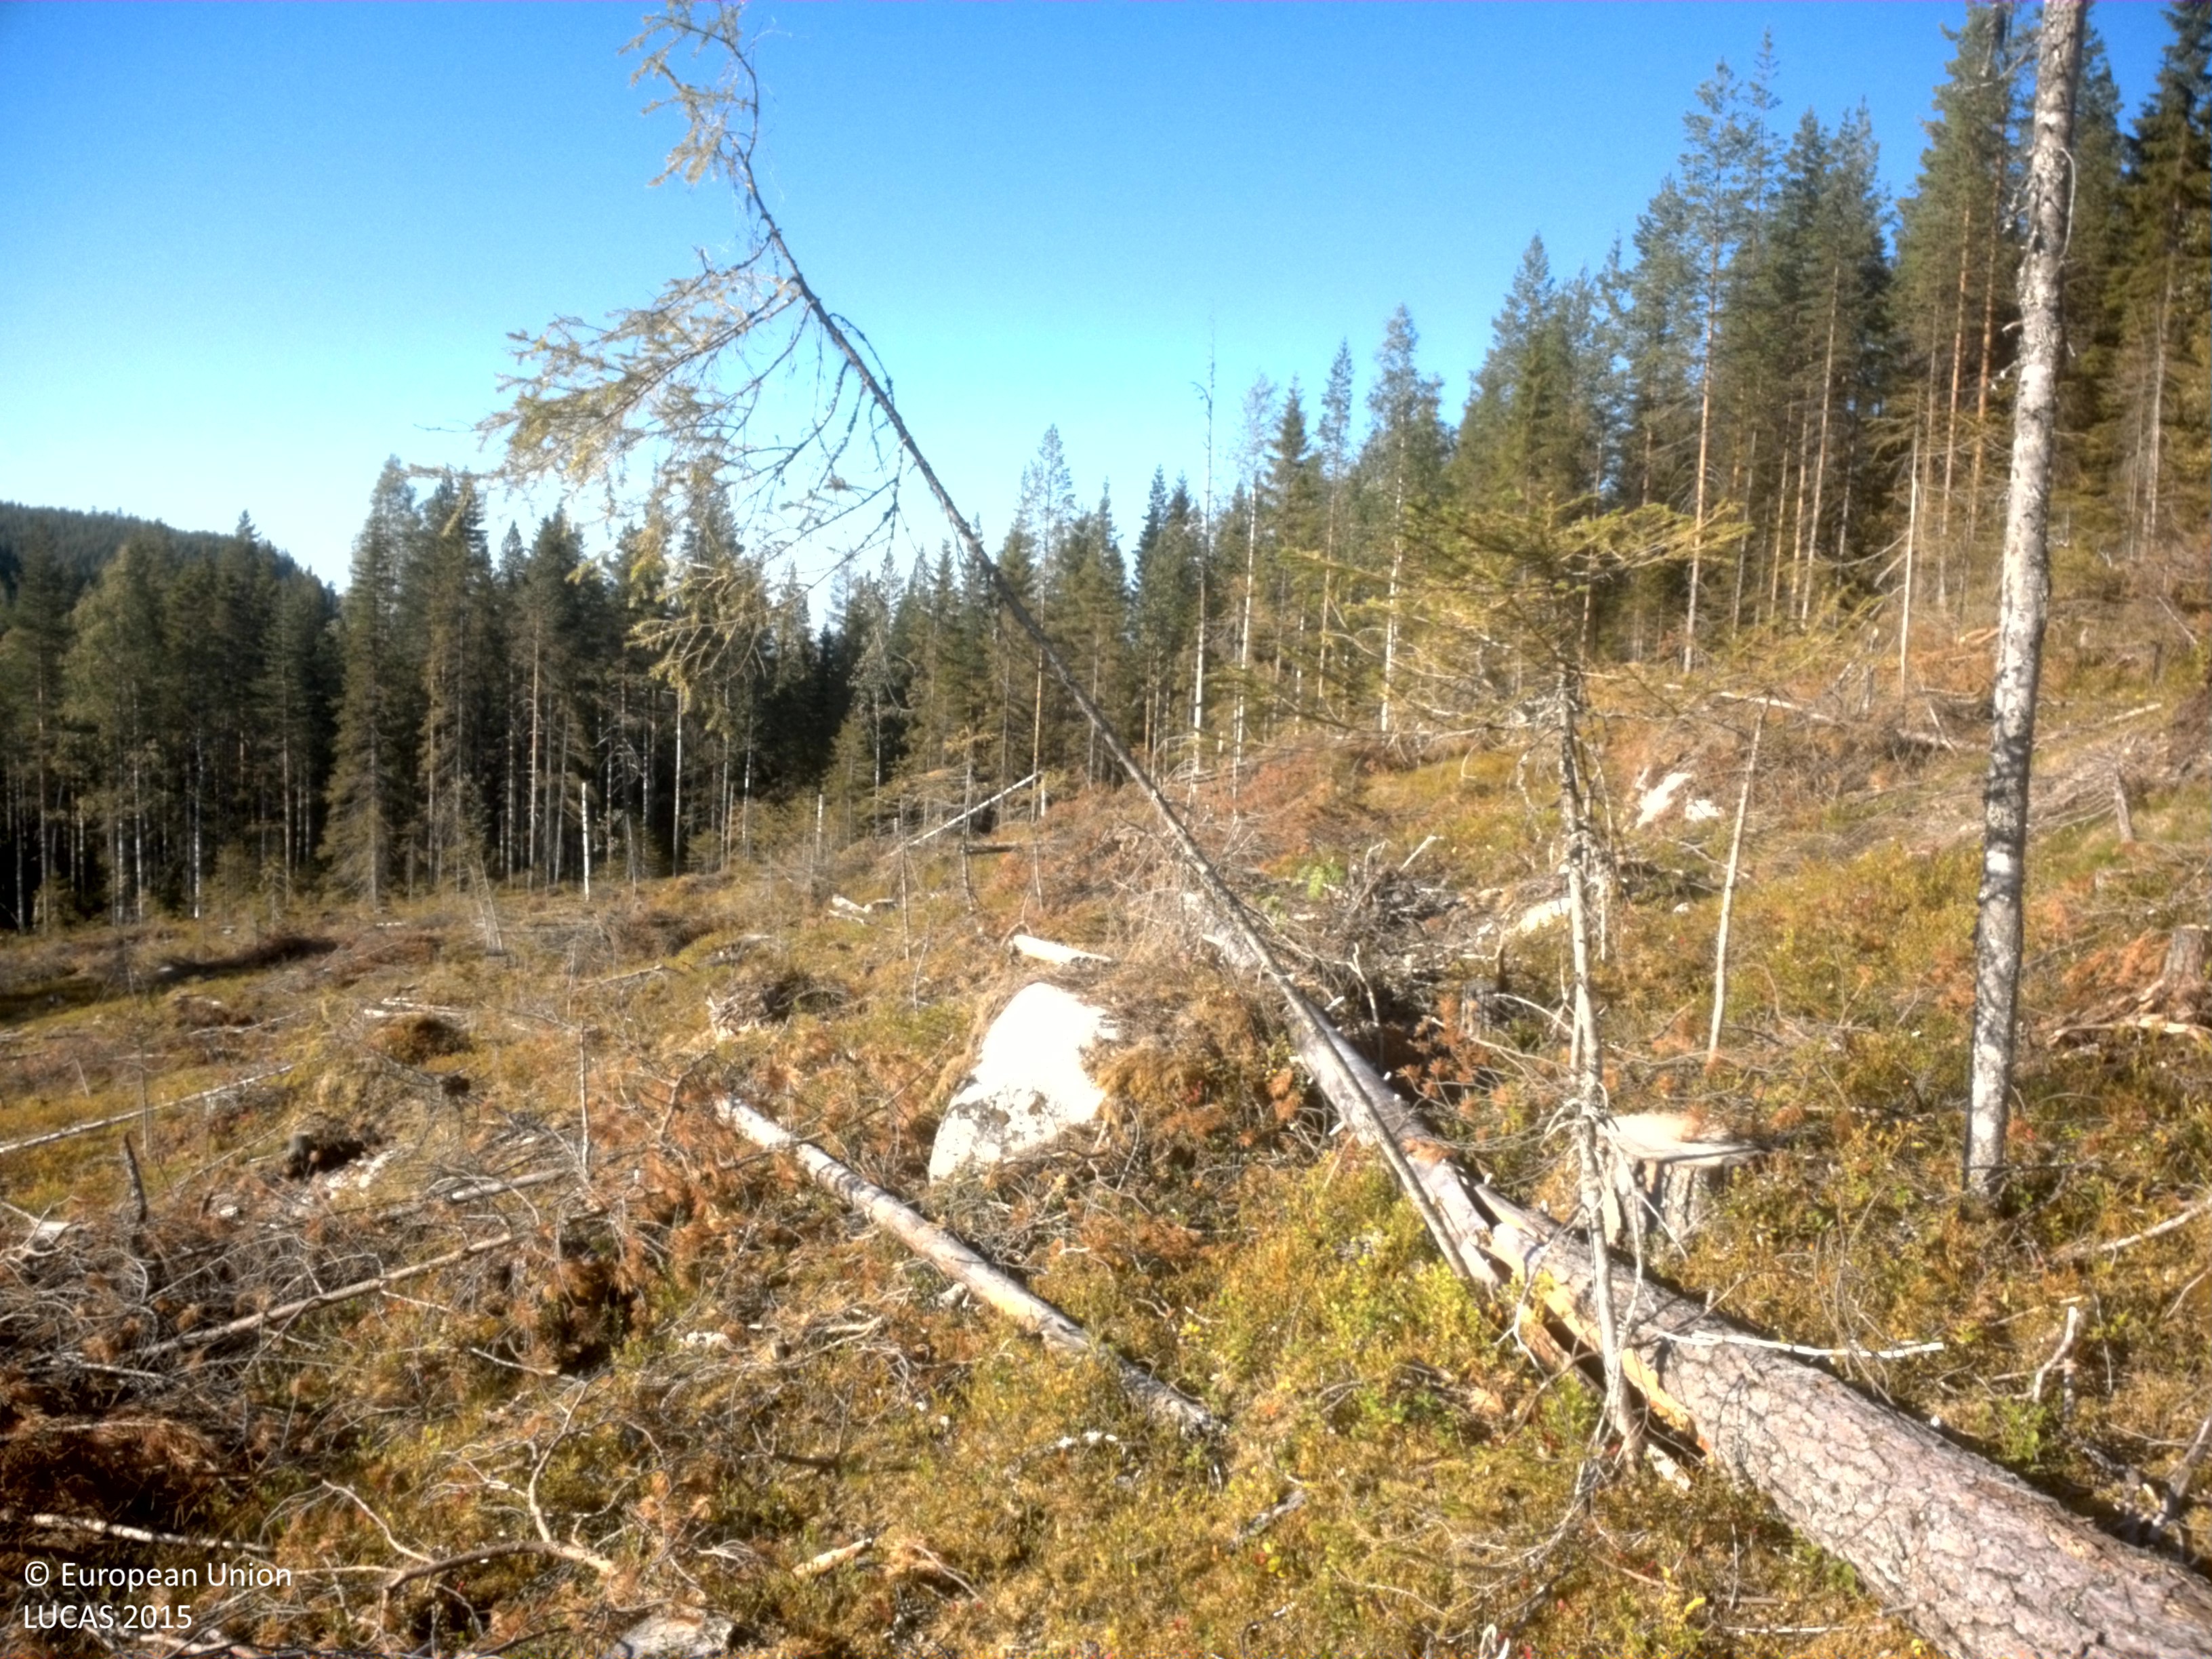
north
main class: Shrubland
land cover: Shrubland with sparse tree cover
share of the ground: > 75 %
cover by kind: shrubs 85 %, lichens and mosses 10 %, coniferous forest trees 5 %
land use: Forestry
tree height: > 5 m
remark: Clear cut
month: August
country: SE
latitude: 64.6275
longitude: 19.1092
